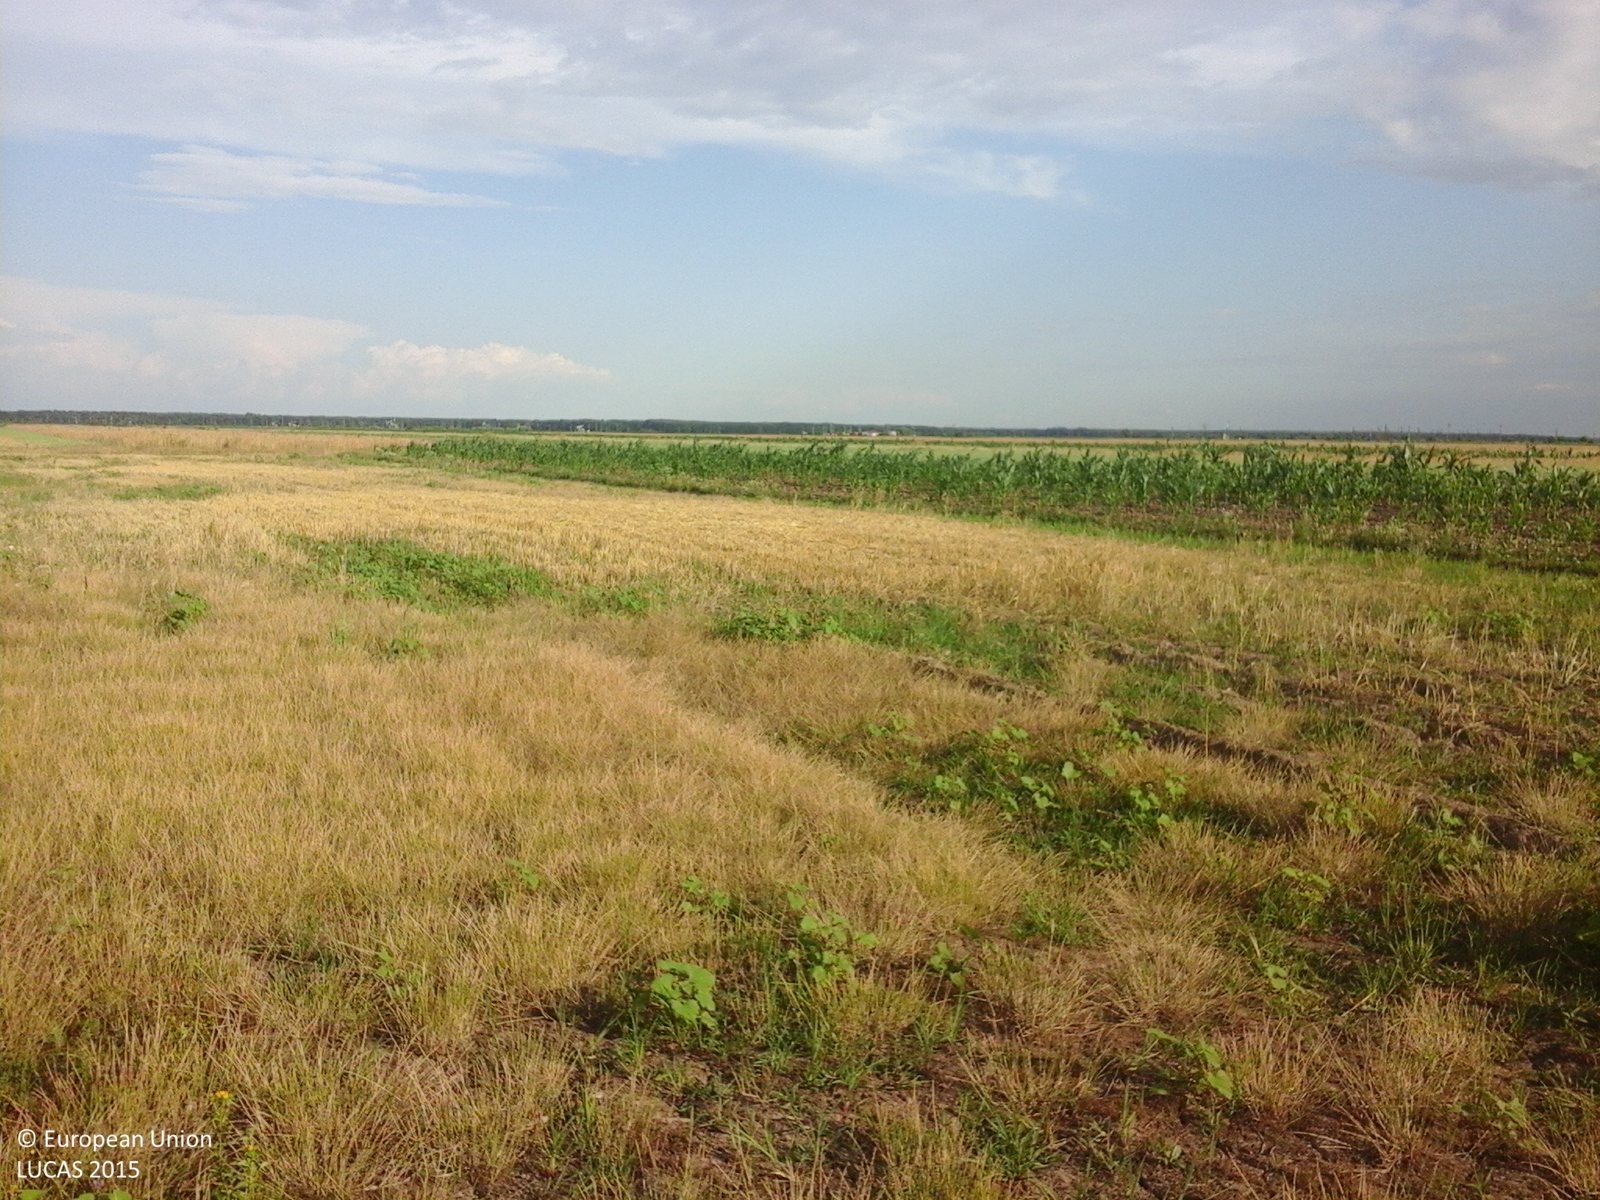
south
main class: Grassland
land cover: Spontaneously vegetated surfaces
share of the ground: < 10 %
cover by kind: herbaceous plants 100 %
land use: Fallow land
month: July
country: RO
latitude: 44.4138
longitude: 25.4489
